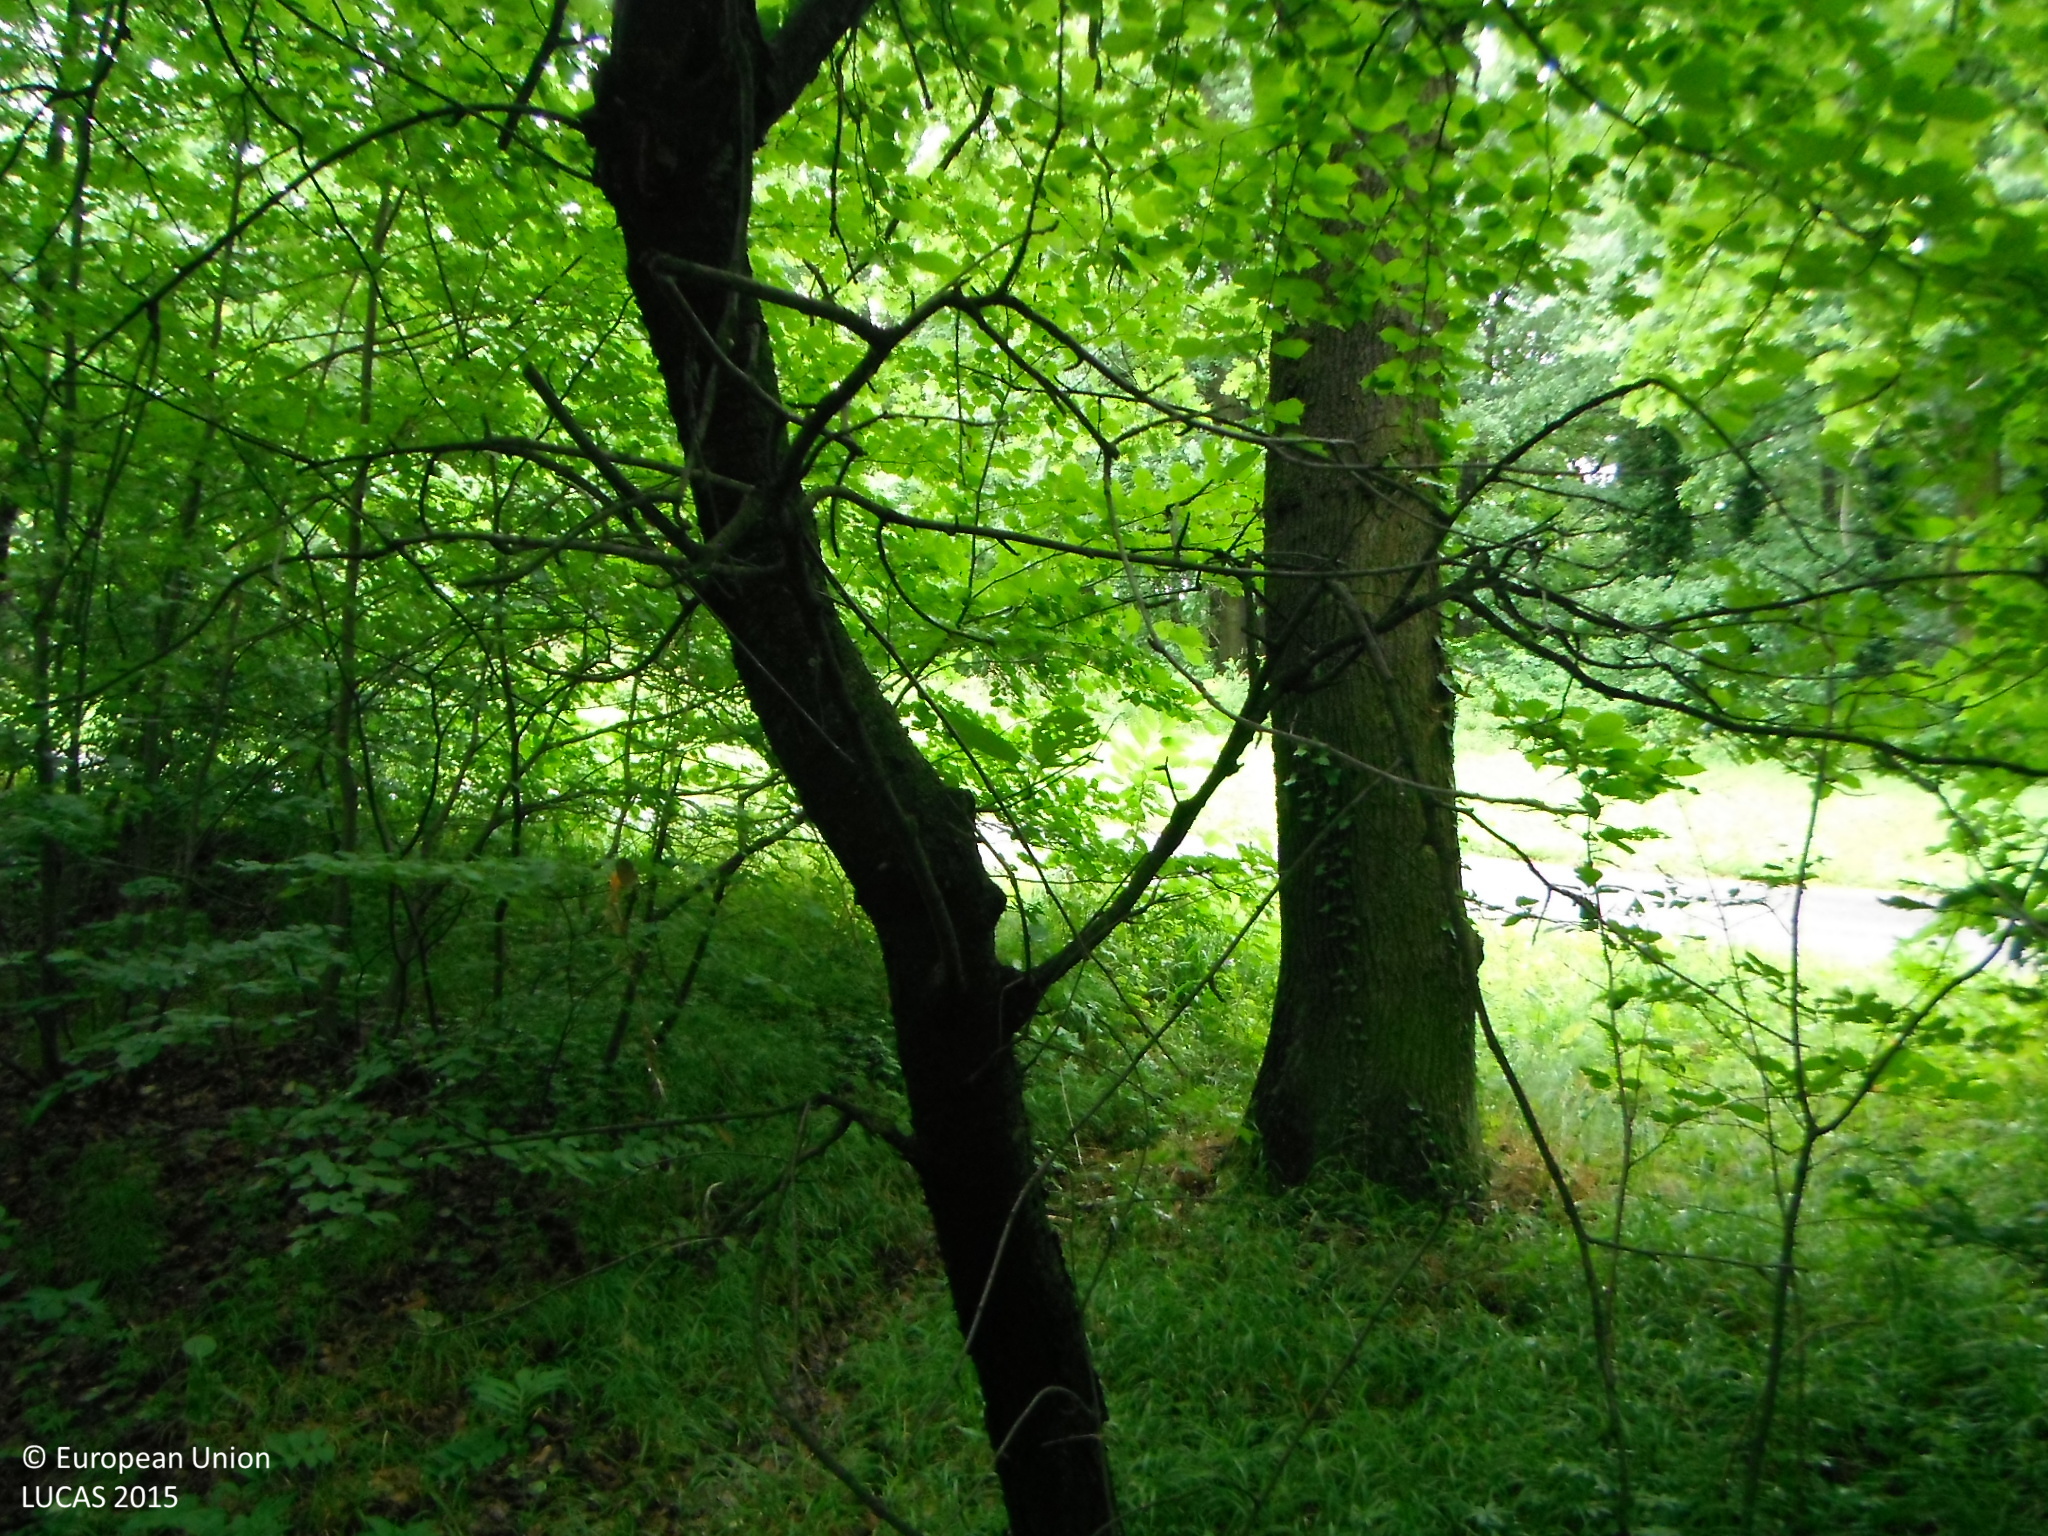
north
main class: Woodland
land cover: Broadleaved woodland
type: mesophytic deciduous forest
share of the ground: > 75 %
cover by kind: broadleaved forest trees 100 %
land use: Forestry
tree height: > 5 m
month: June
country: SK
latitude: 48.1610
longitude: 17.0390
